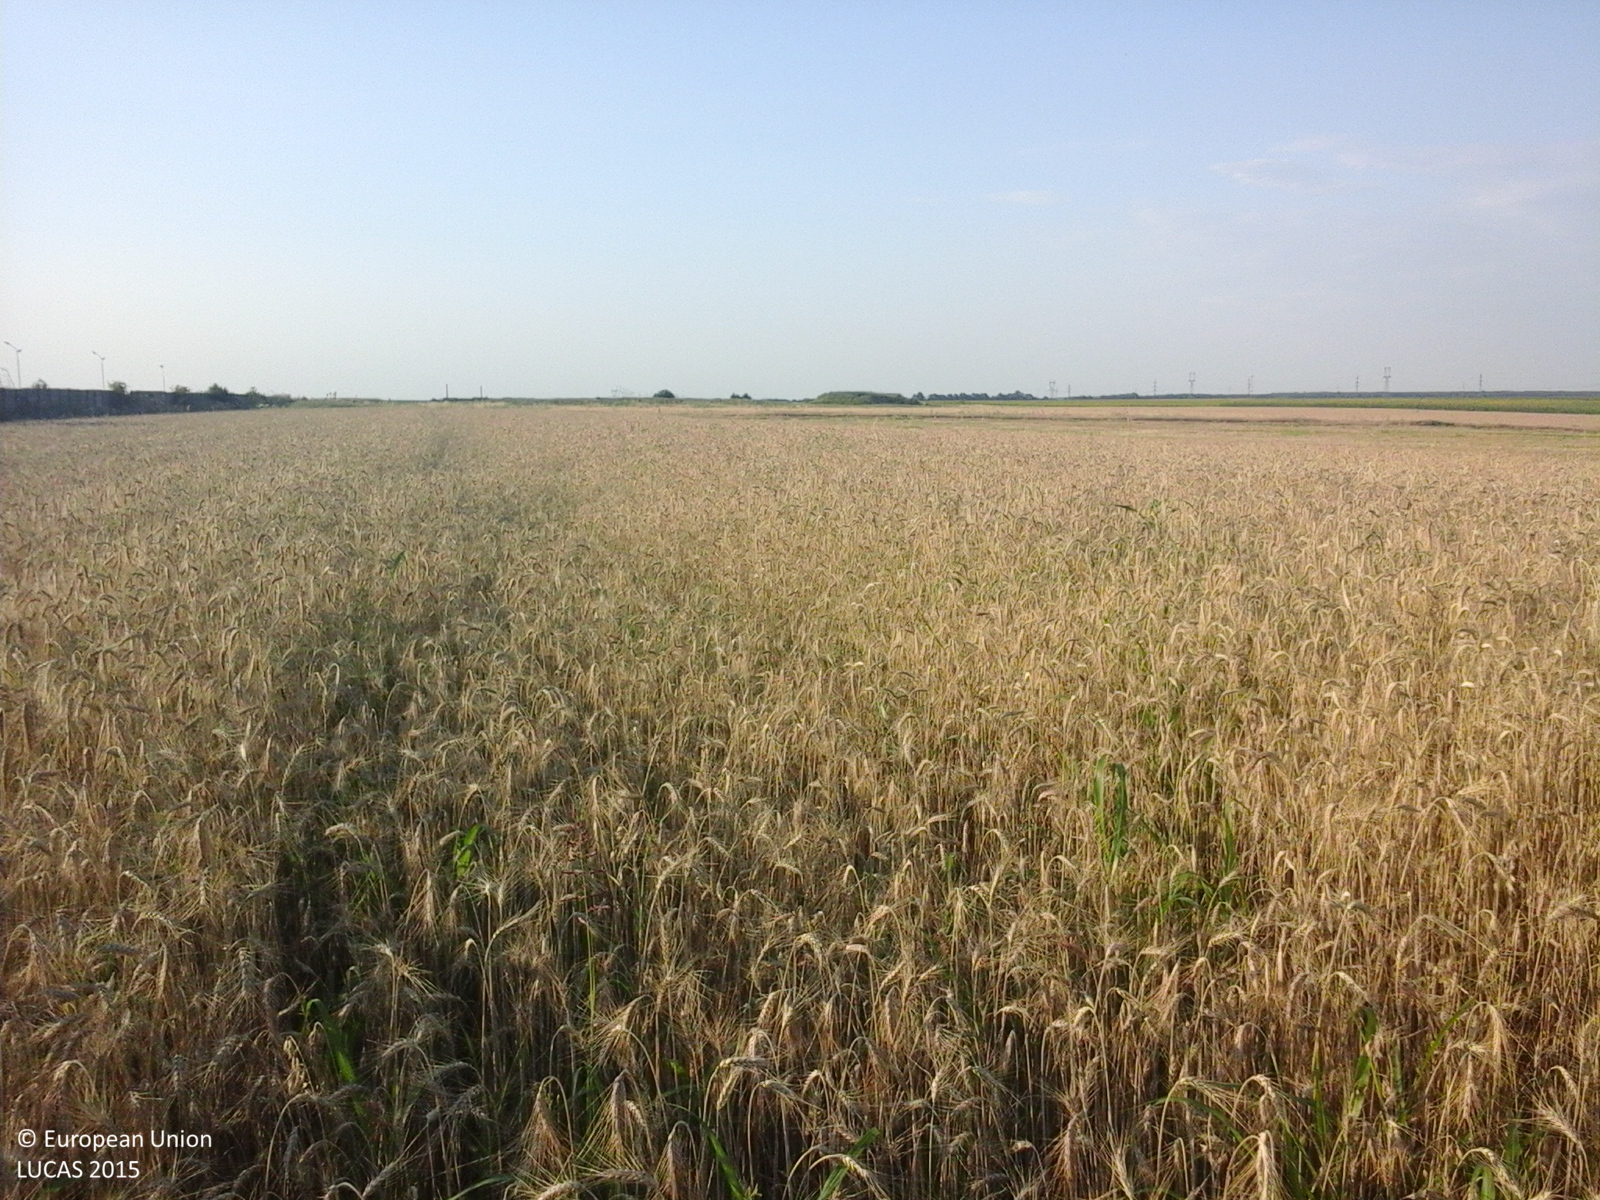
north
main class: Cropland
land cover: Common wheat
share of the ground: > 75 %
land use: Agriculture (excluding fallow land and kitchen gardens)
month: July
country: RO
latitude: 44.3068
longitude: 24.4212
